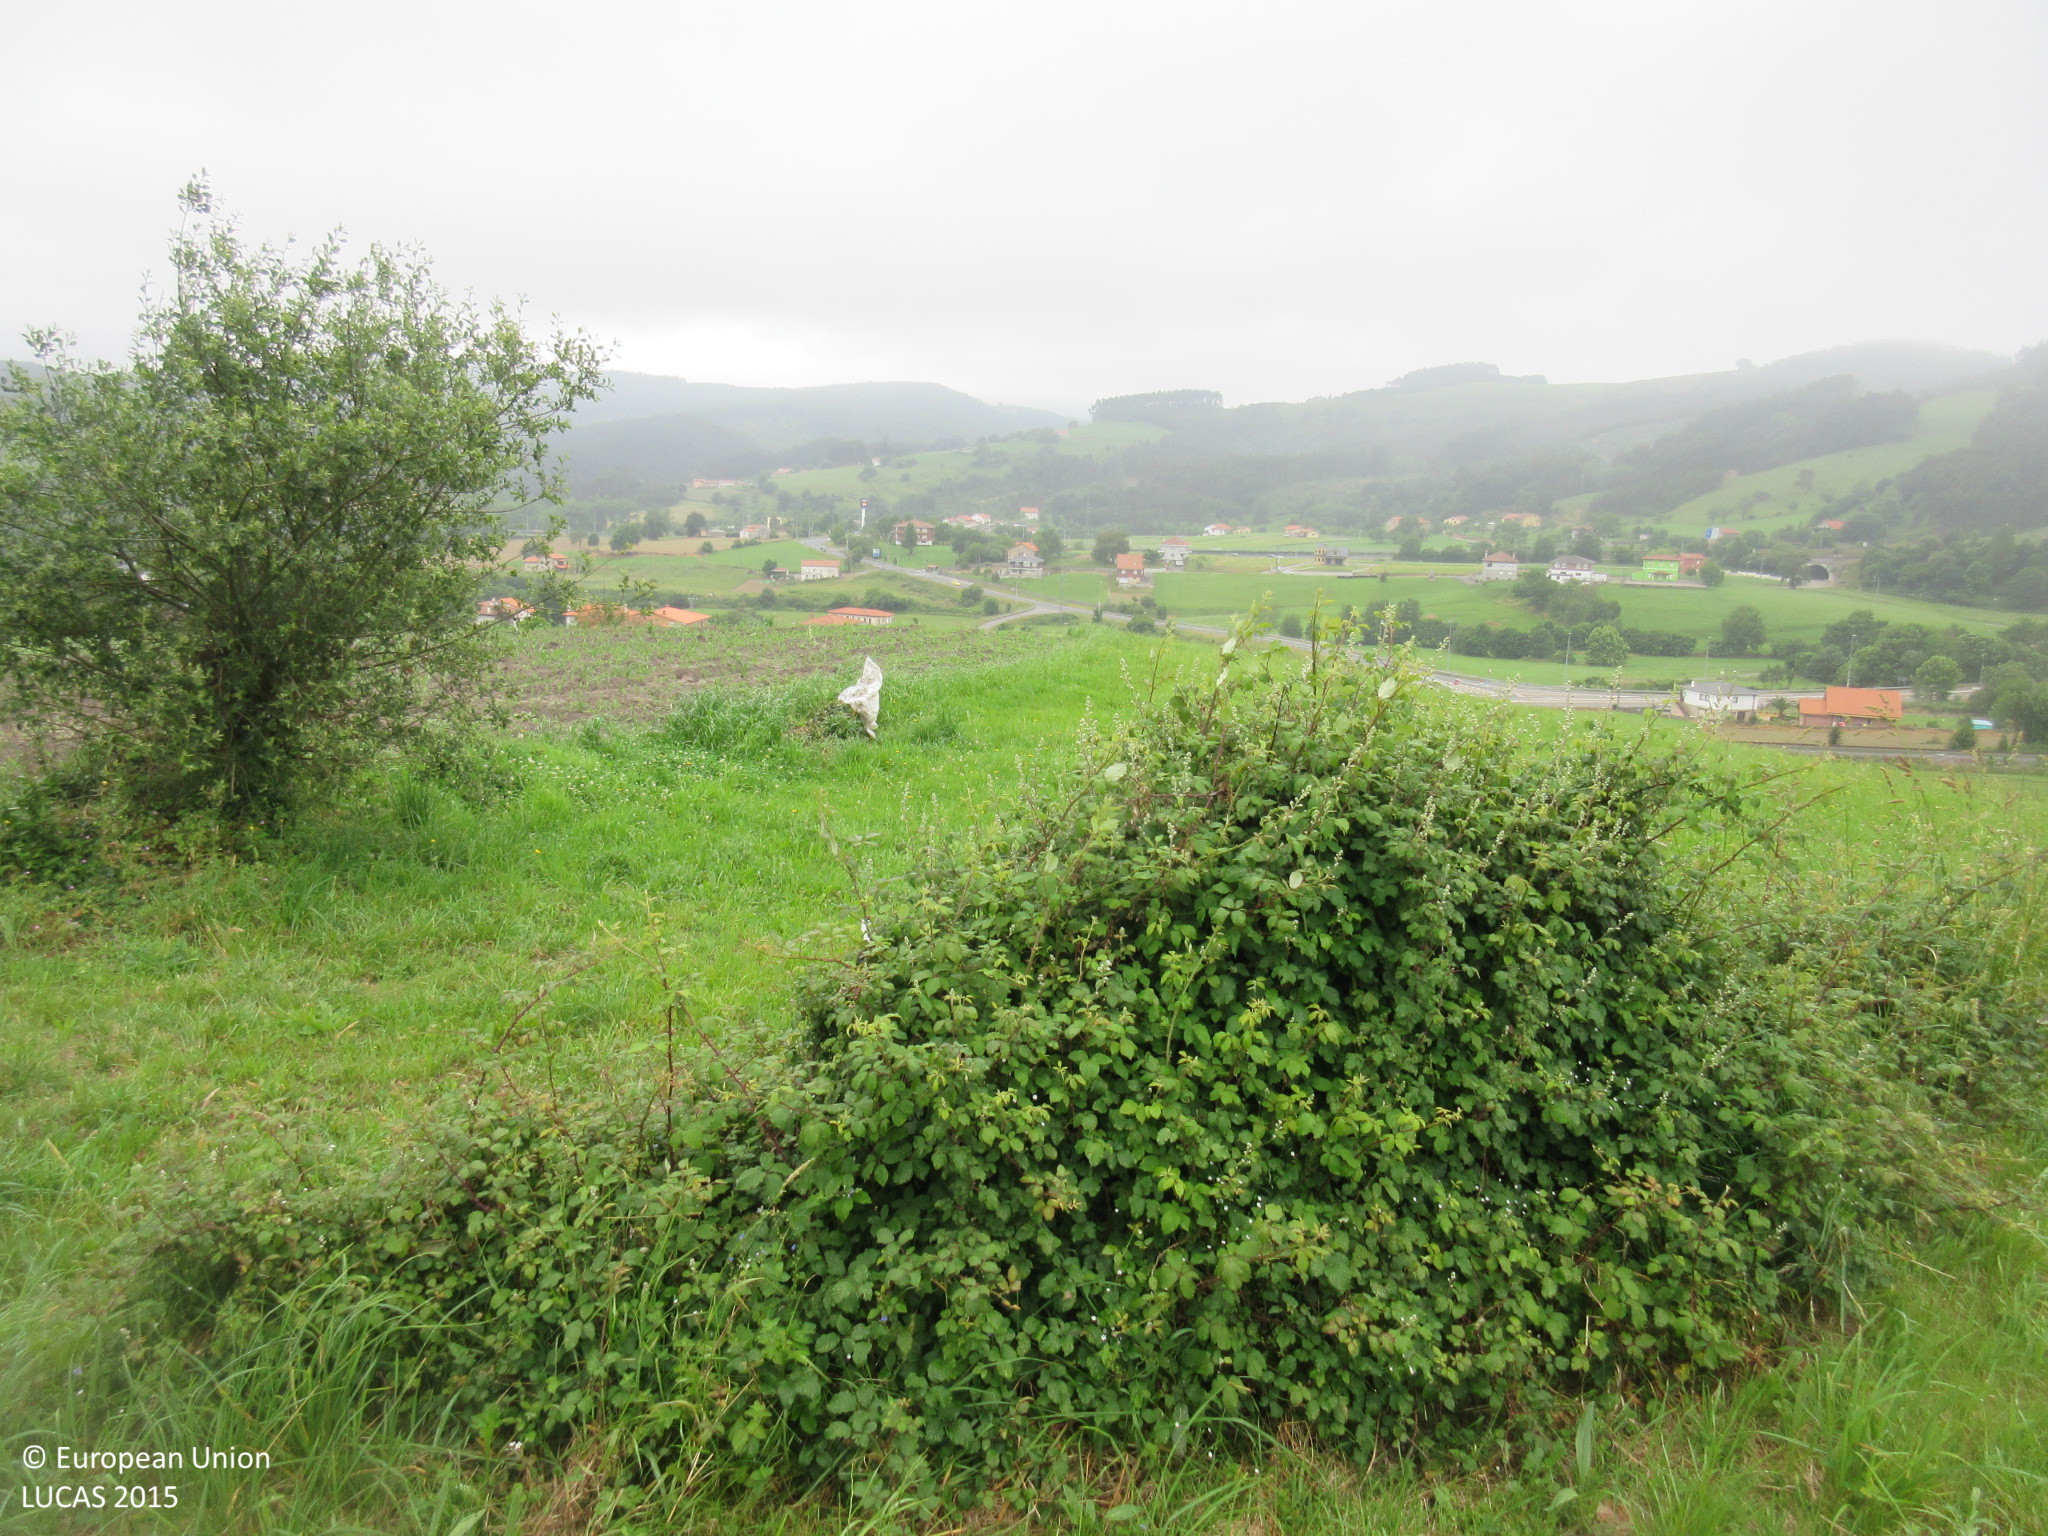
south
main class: Grassland
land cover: Grassland without tree/shrub cover
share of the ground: > 75 %
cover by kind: herbaceous plants 100 %
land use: Agriculture (excluding fallow land and kitchen gardens)
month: June
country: ES
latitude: 43.4212
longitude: -3.5447
